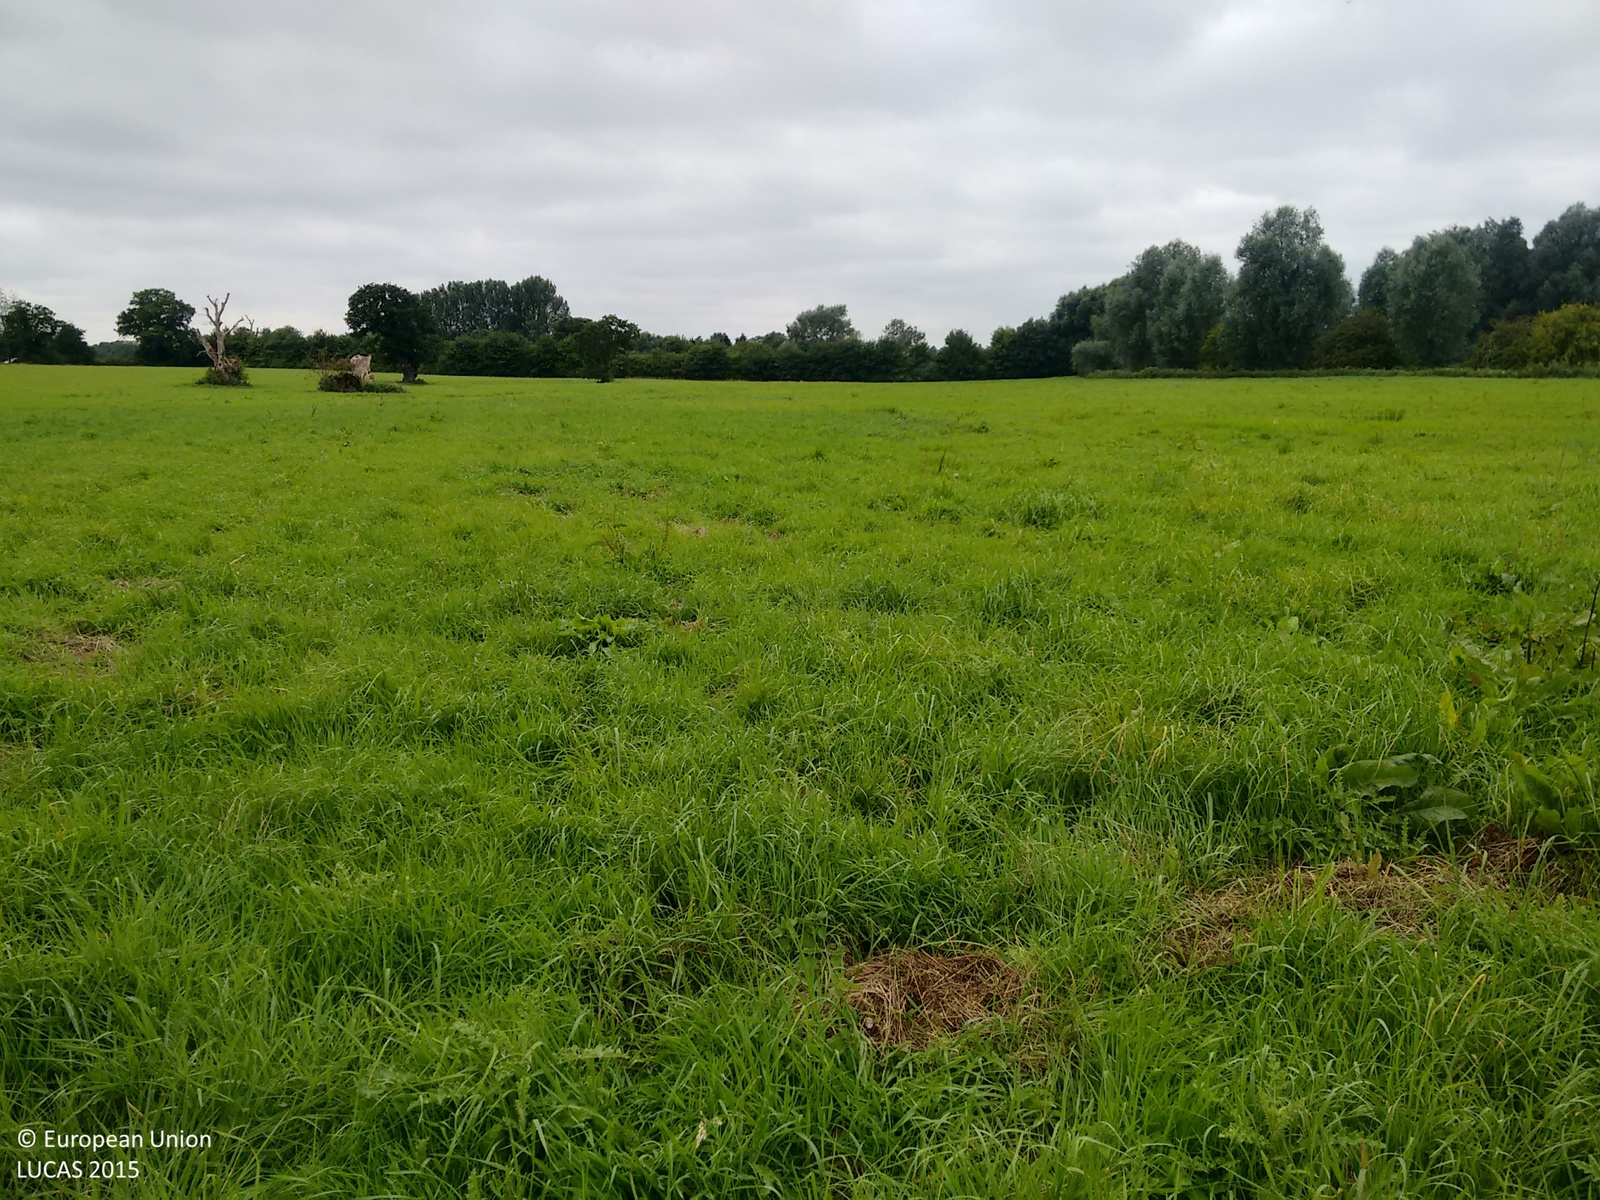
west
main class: Grassland
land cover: Grassland without tree/shrub cover
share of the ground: > 75 %
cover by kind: herbaceous plants 100 %
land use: Agriculture (excluding fallow land and kitchen gardens)
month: September
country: GB
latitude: 52.2809
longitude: 0.9028
